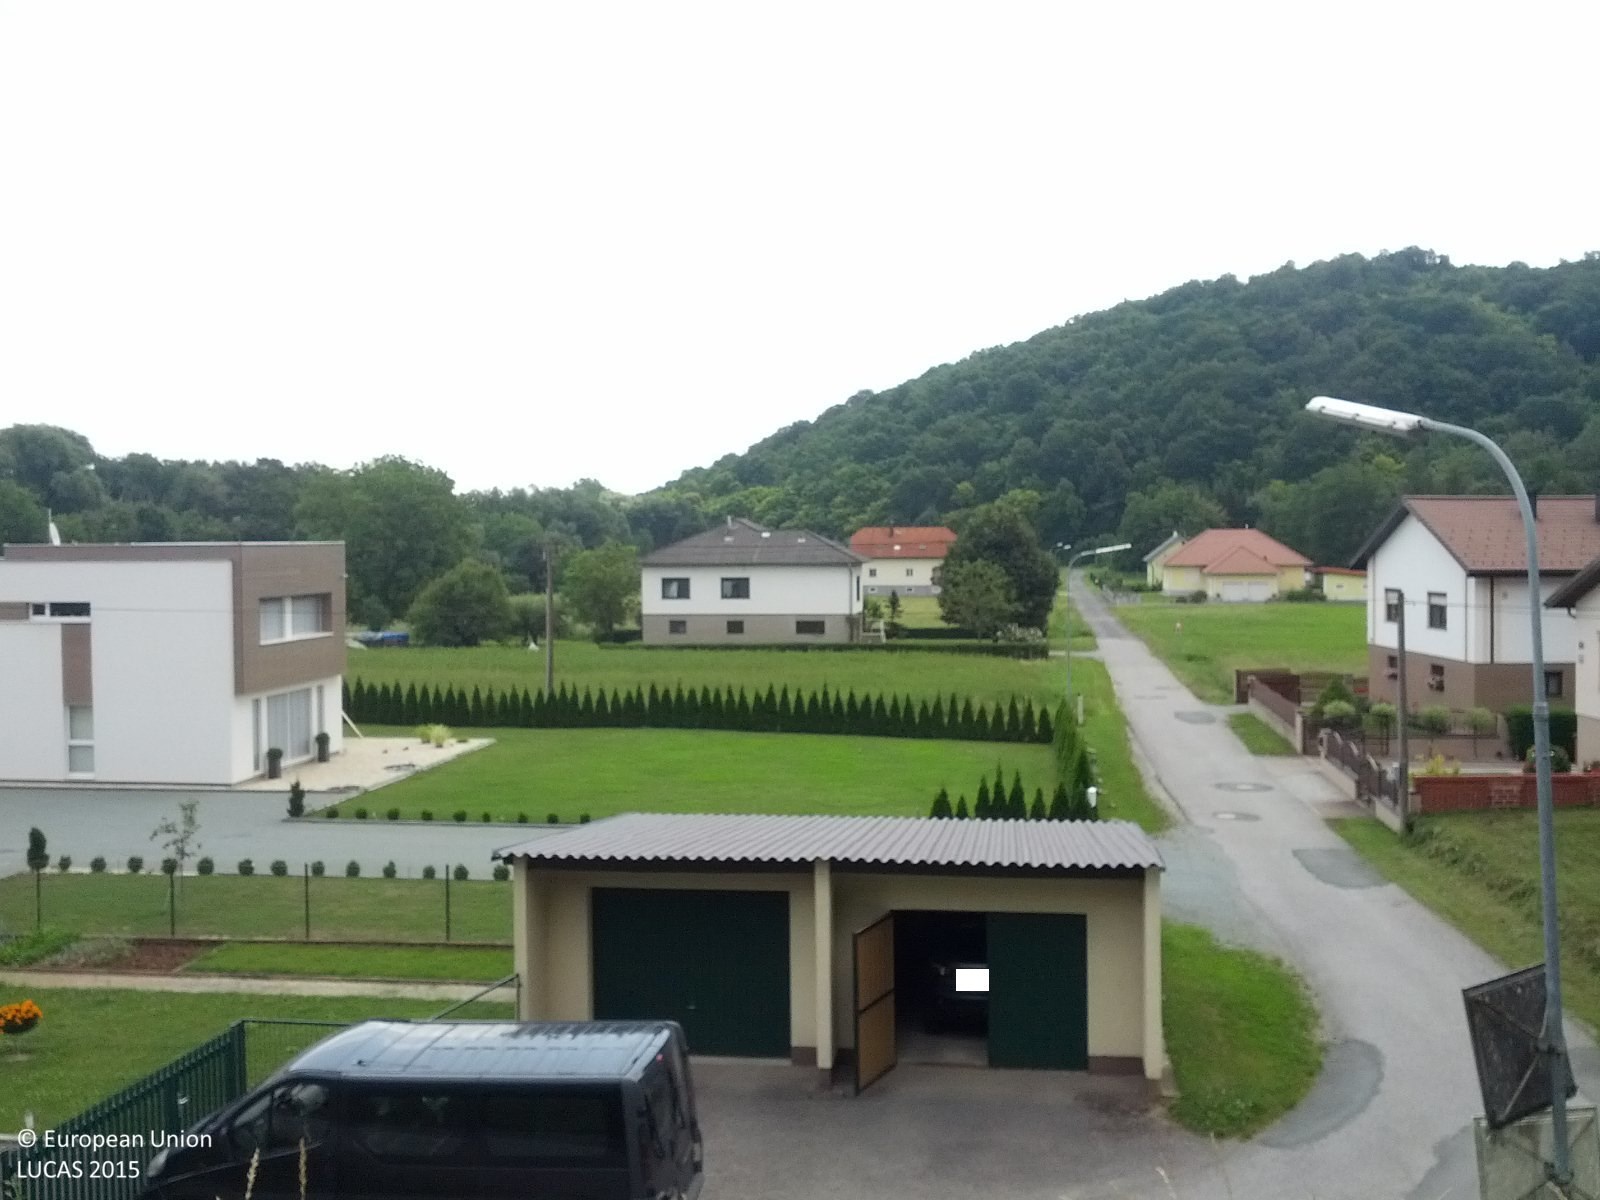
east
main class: Grassland
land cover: Grassland without tree/shrub cover
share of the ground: > 75 %
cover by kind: herbaceous plants 100 %
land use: Road transport
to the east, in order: Grassland without tree/shrub cover; Artificial constructions in urban areas; Grassland without tree/shrub cover; Electric lines; Grassland without tree/shrub cover; Artificial constructions in urban areas; Grassland without tree/shrub cover; Fences; Grassland without tree/shrub cover; Electric lines; Common wheat; Fences; Grass margins; Ditches and canals; Shrubland with sparse tree cover; Railways
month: July
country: AT
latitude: 47.2262
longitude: 16.3816
